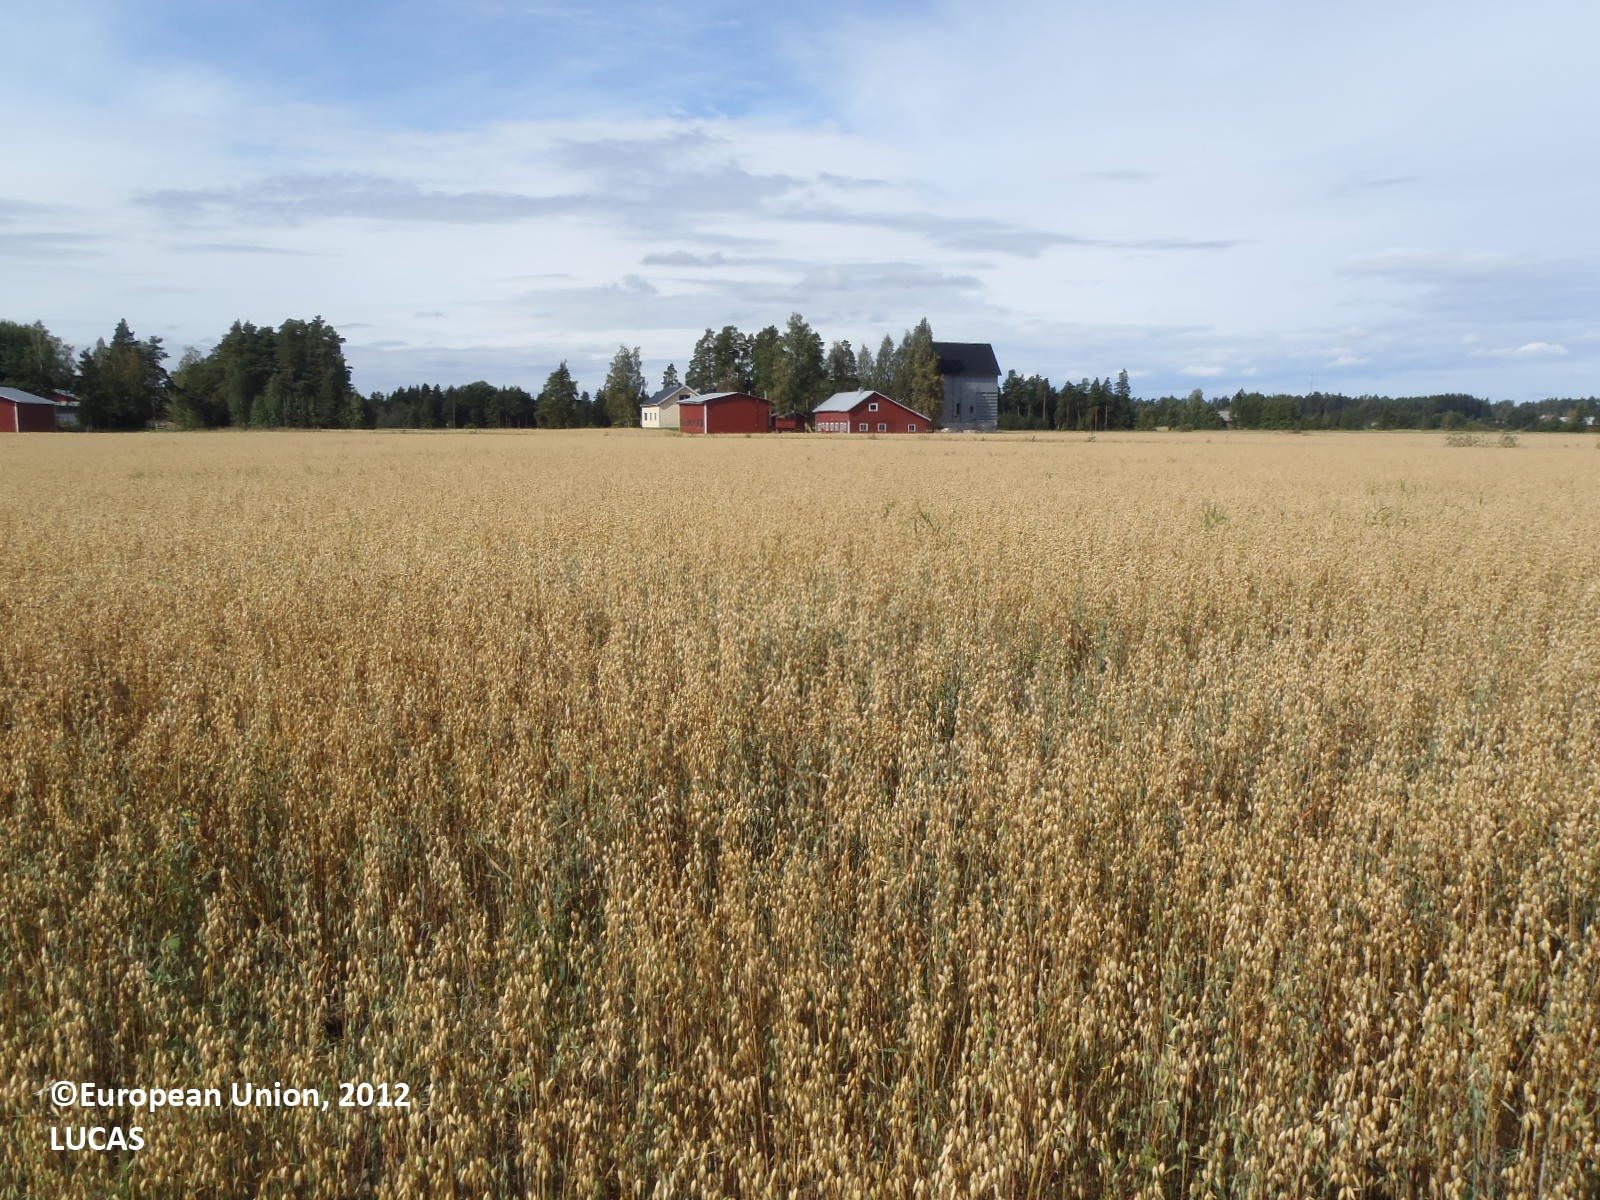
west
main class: Cropland
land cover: Oats
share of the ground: > 75 %
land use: Agriculture (excluding fallow land and kitchen gardens)
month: August
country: FI
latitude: 60.7070
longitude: 22.6216
